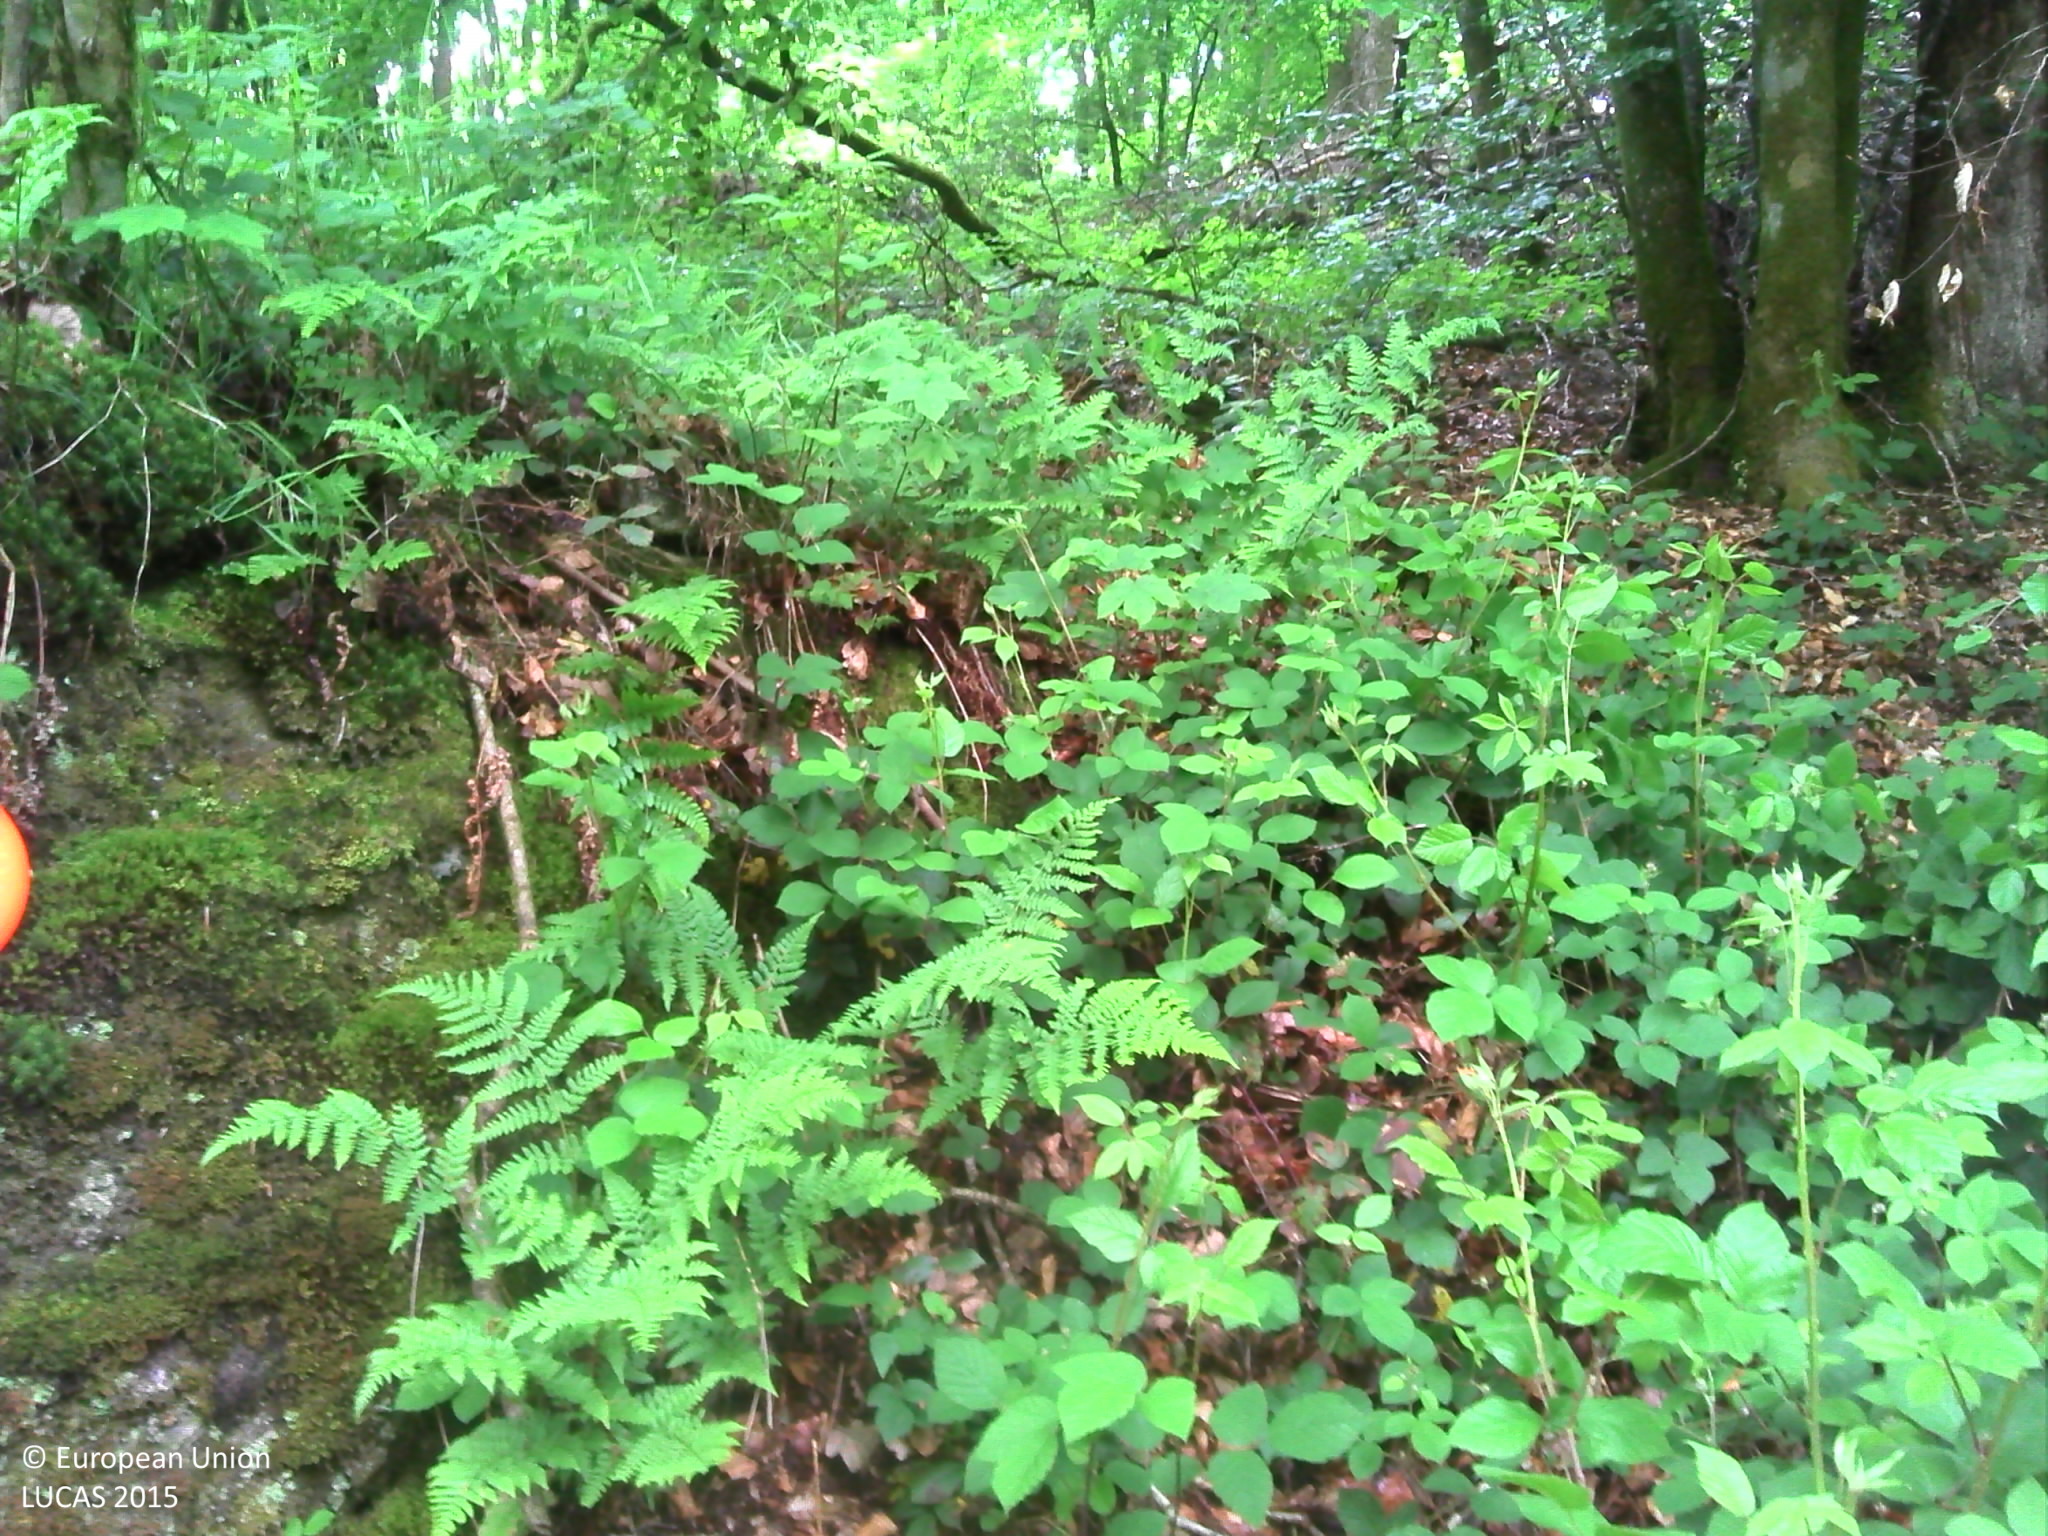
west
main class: Woodland
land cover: Broadleaved woodland
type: acidophilous oak and oak-birch forest
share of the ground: > 75 %
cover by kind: broadleaved forest trees 95 %, herbaceous plants 5 %
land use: Forestry
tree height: > 5 m
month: June
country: BE
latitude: 49.8895
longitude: 4.8888
